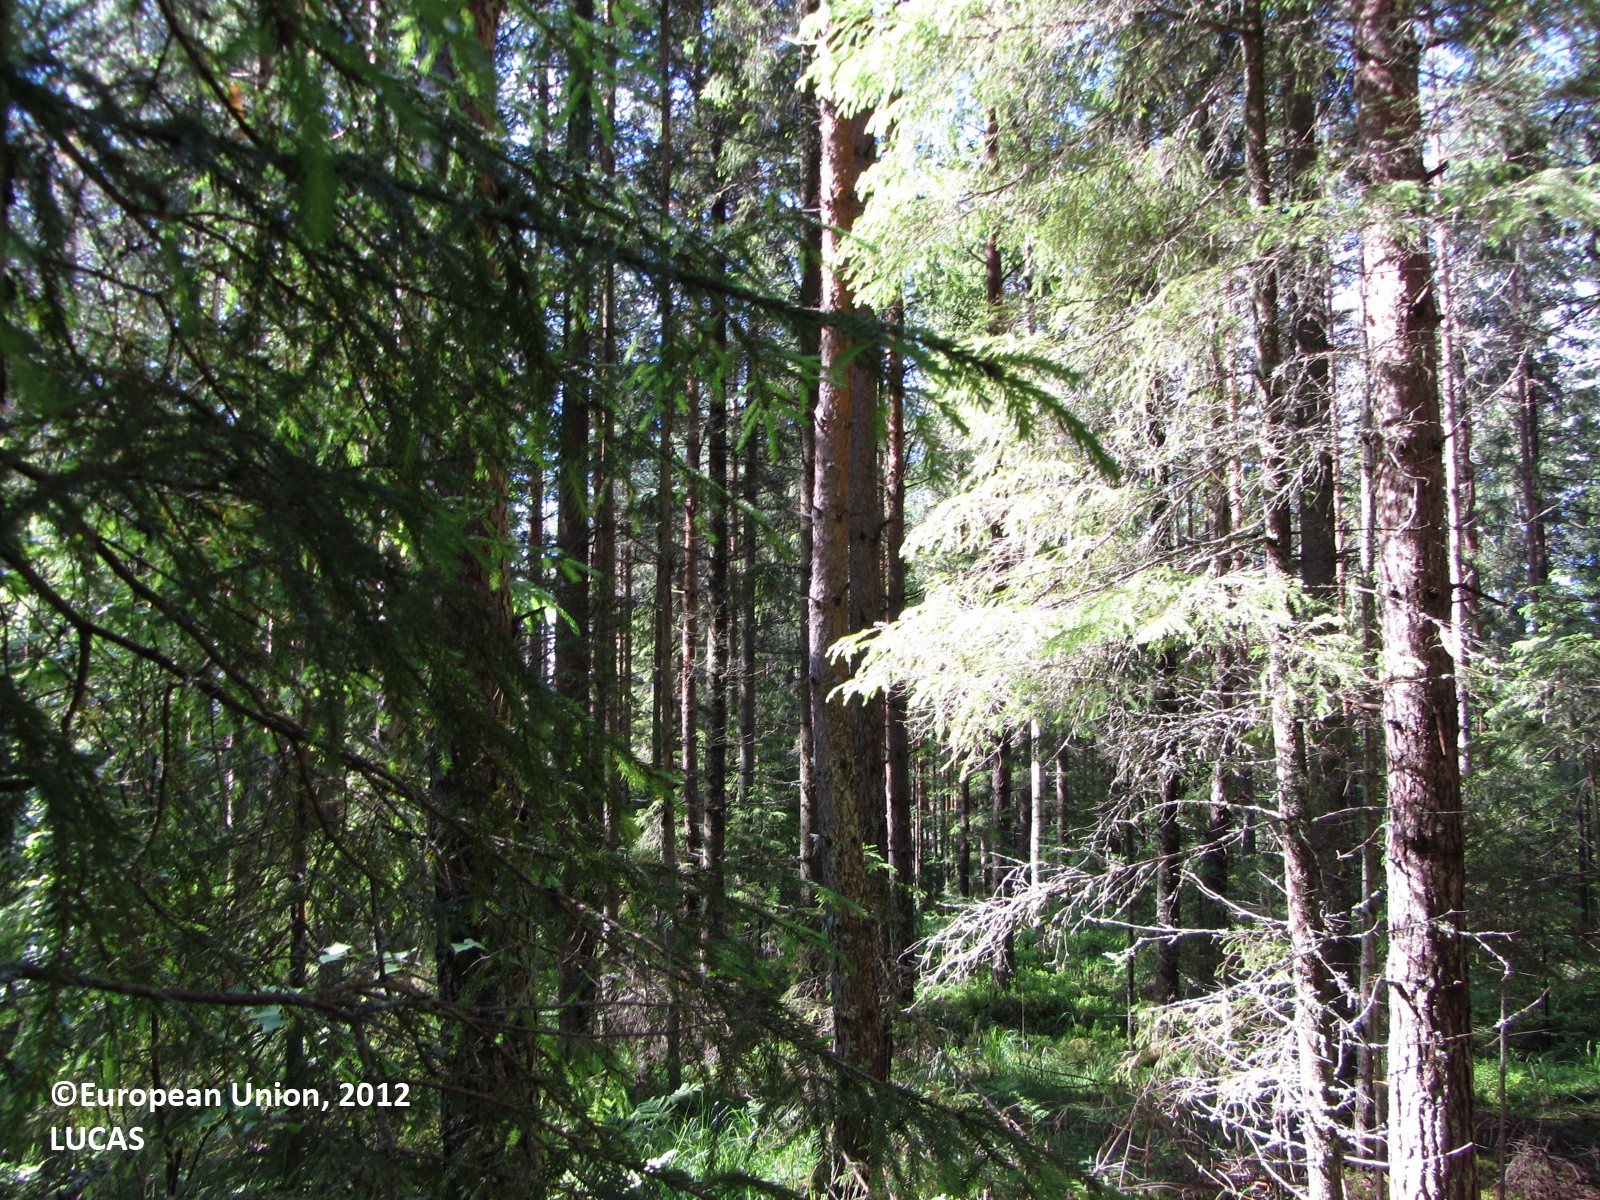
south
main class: Woodland
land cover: Other coniferous woodland
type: boreal forest
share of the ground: 50 - 75 %
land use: Forestry
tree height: > 5 m
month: June
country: FI
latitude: 62.1211
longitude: 25.2735
